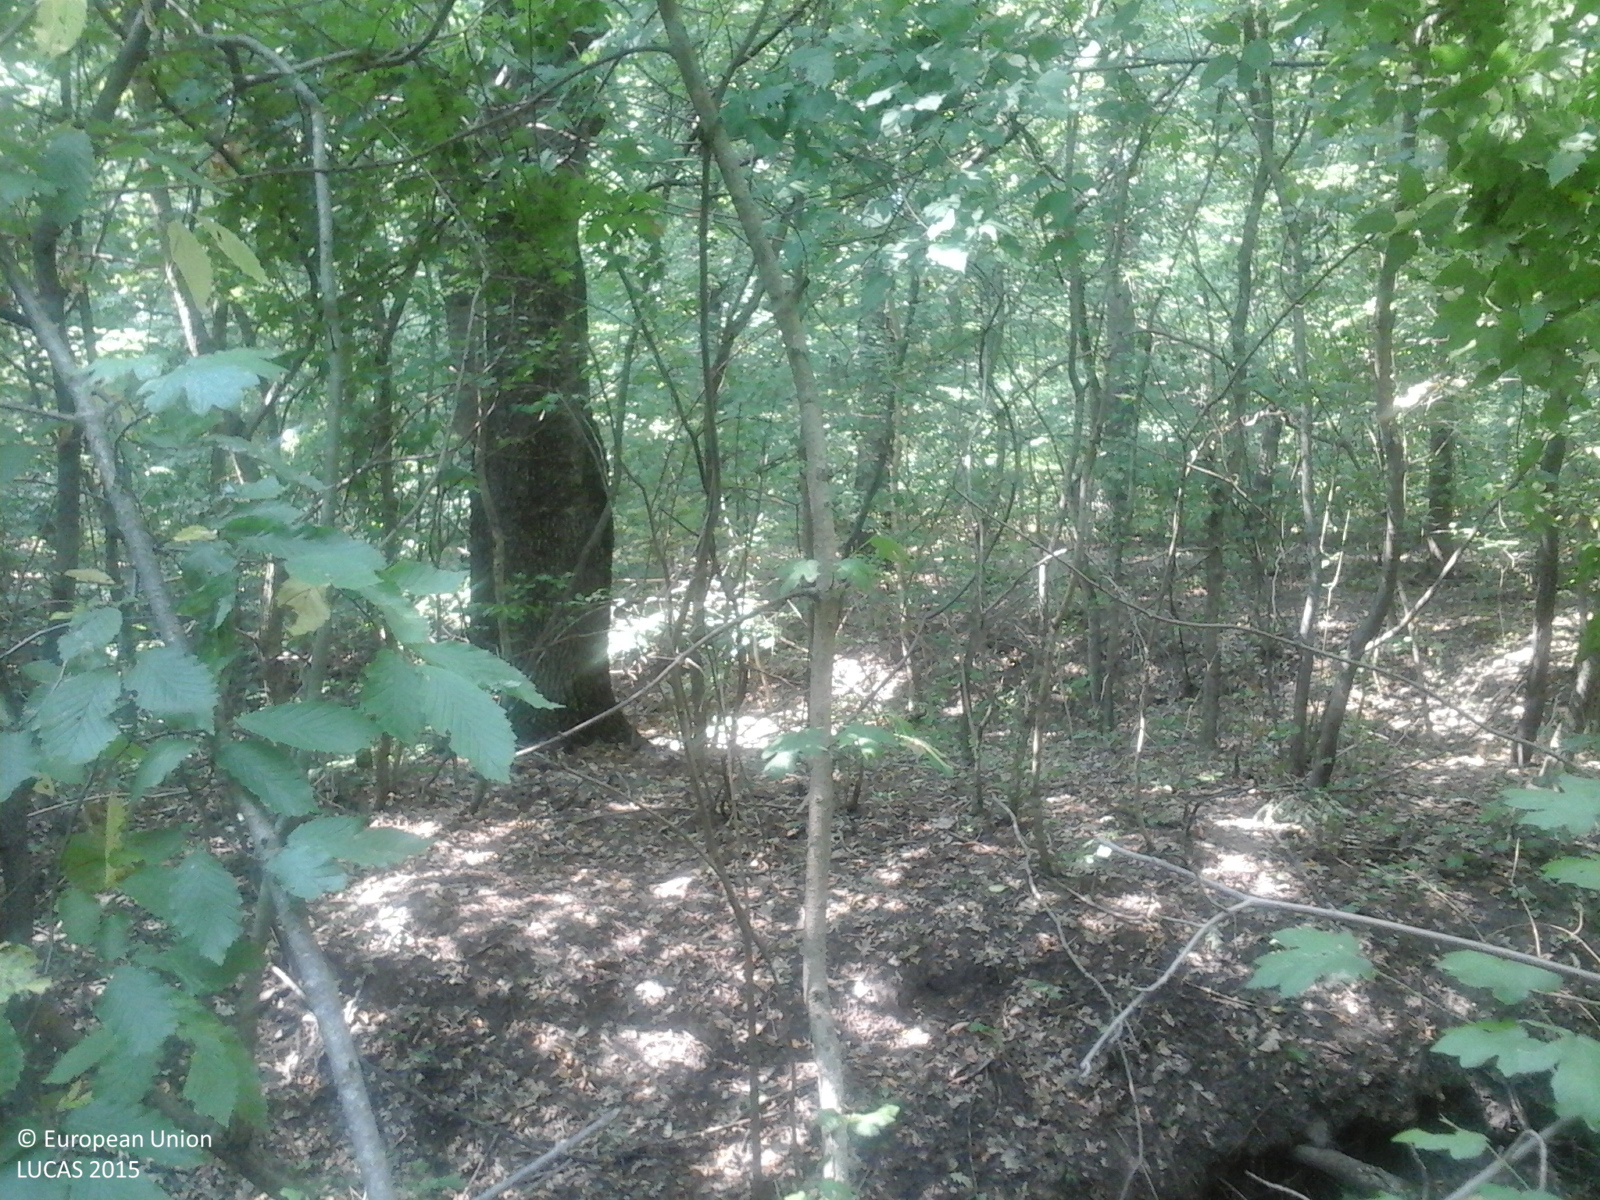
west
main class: Woodland
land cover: Broadleaved woodland
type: acidophilous oak and oak-birch forest
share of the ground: > 75 %
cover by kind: broadleaved forest trees 100 %
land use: Forestry
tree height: > 5 m
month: July
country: RO
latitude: 46.3910
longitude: 27.5770
